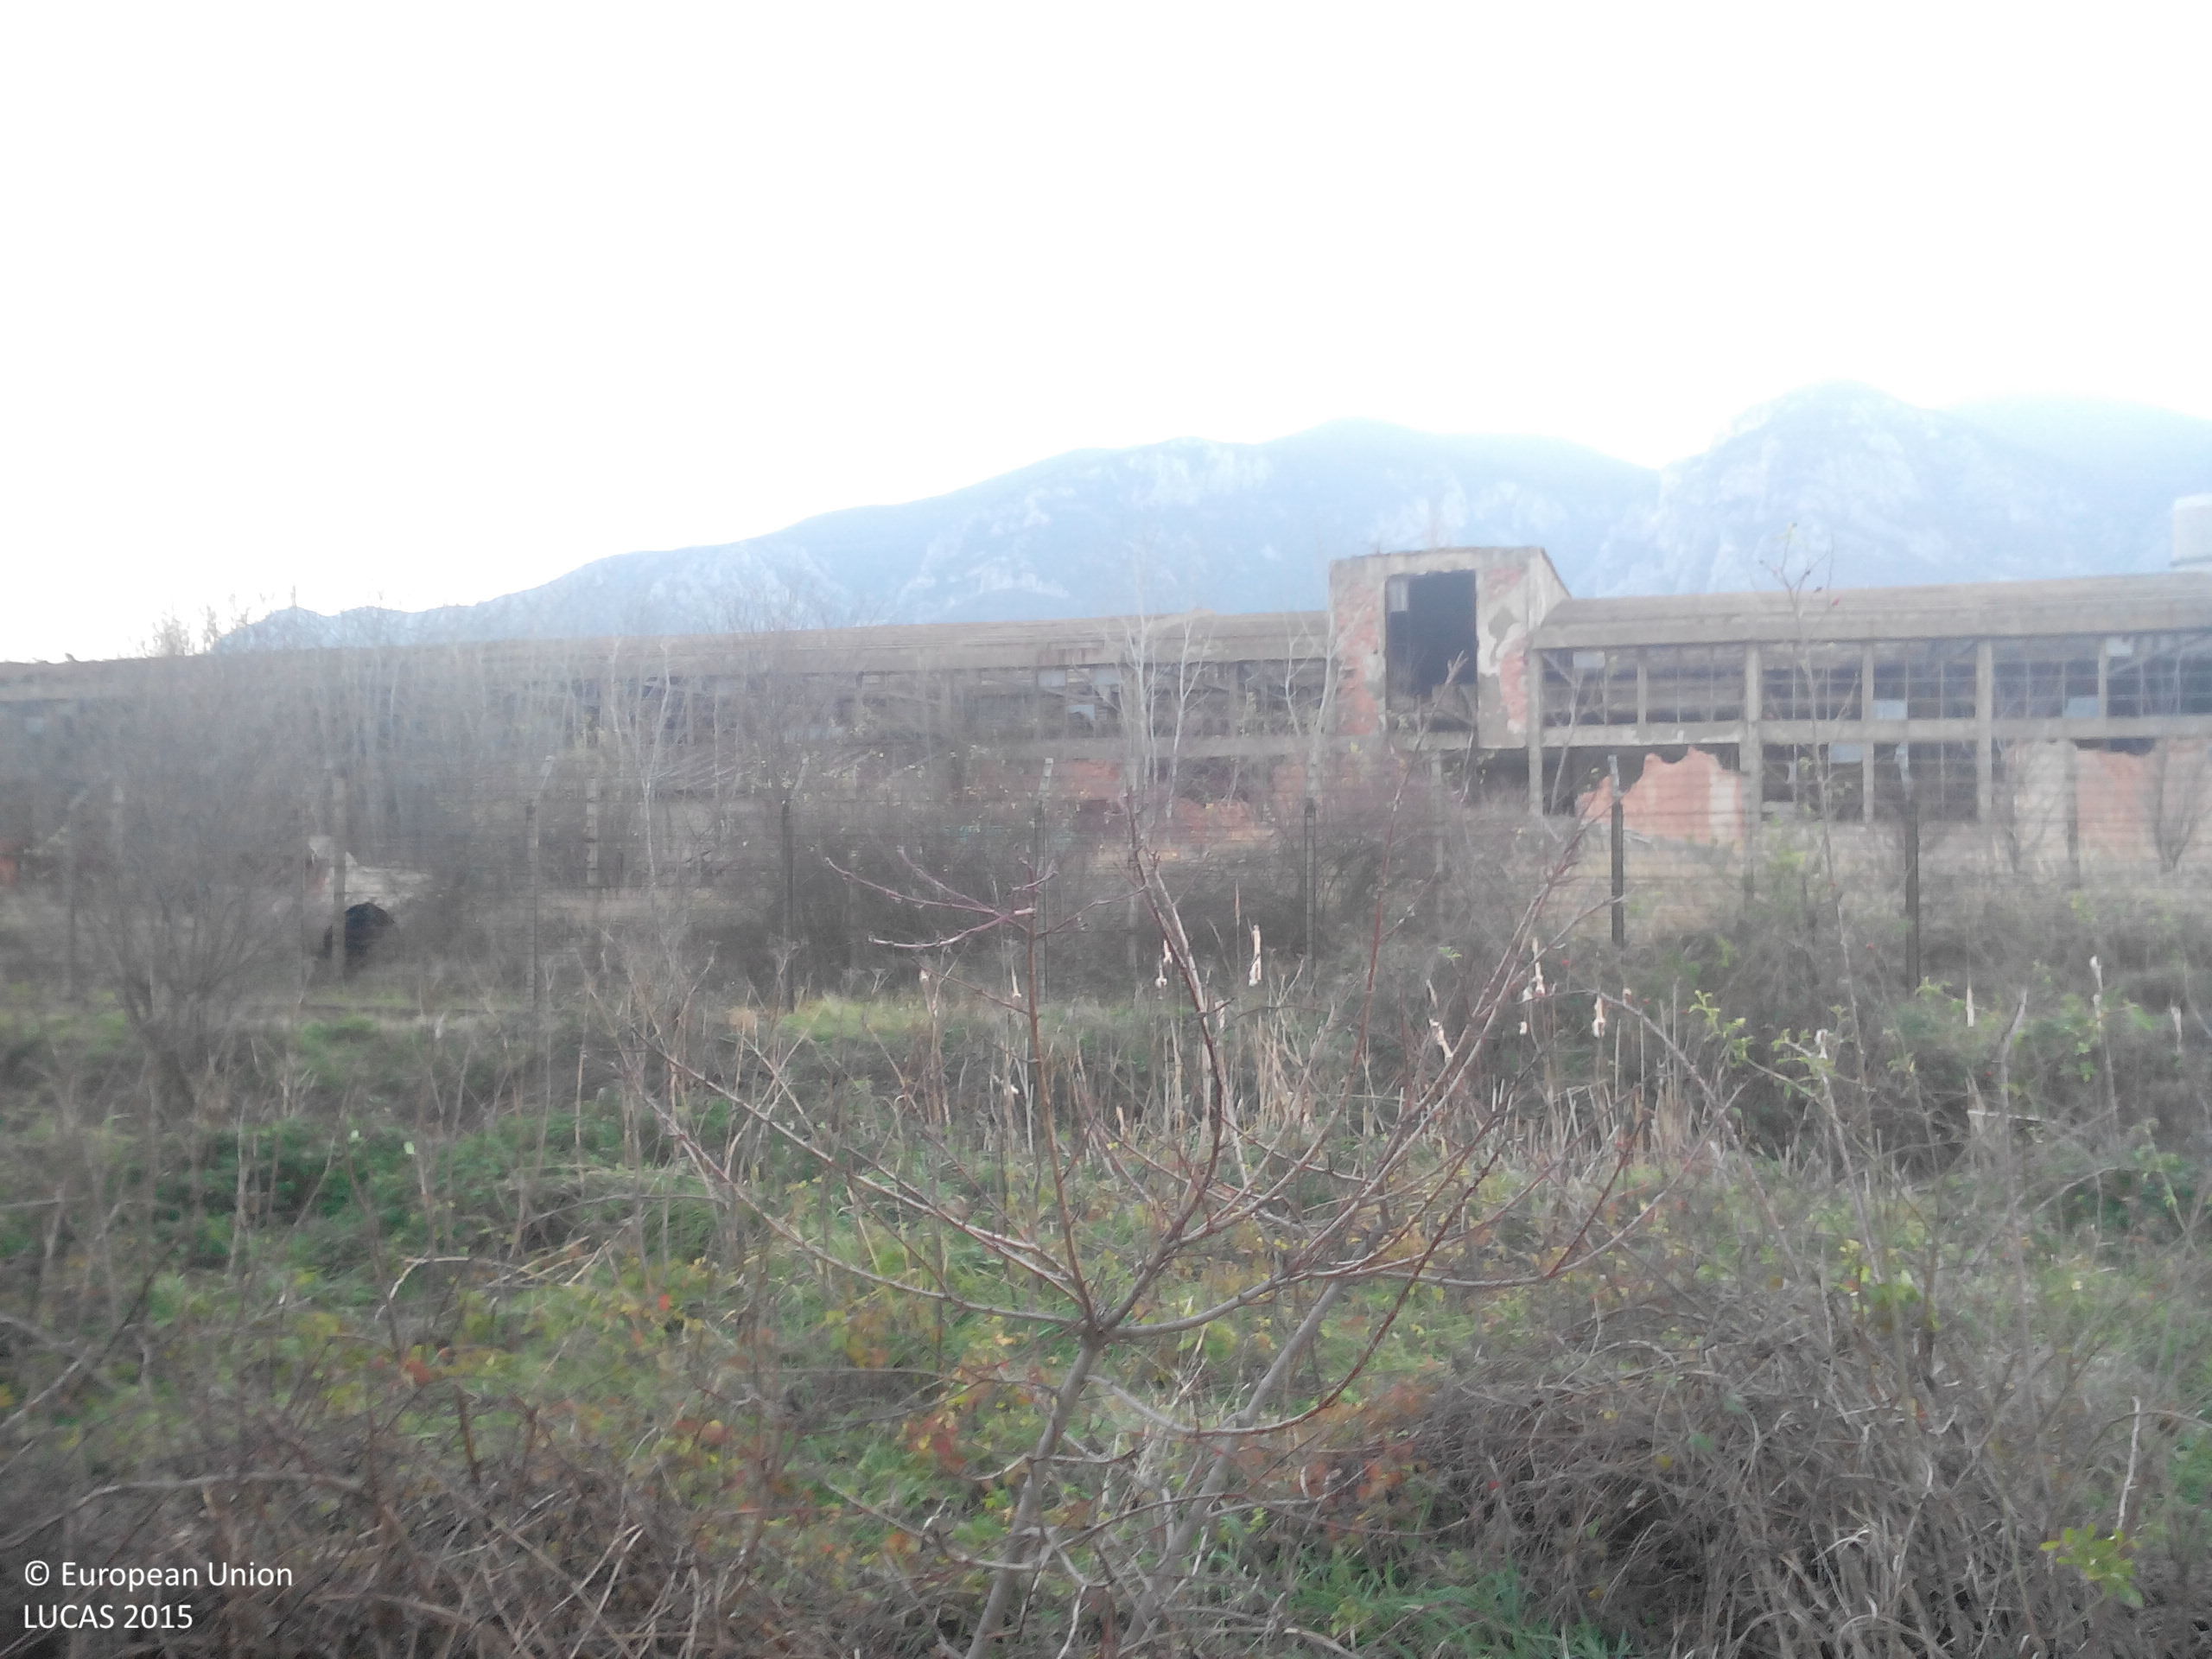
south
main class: Woodland
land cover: Broadleaved woodland
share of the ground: 25 - 50 %
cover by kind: shrubs 45 %, herbaceous plants 25 %, broadleaved forest trees 20 %, unconsolidated bare surface 10 %
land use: Machinery and equipment
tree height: < 5 m
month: December
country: BG
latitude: 43.1957
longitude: 23.5919
